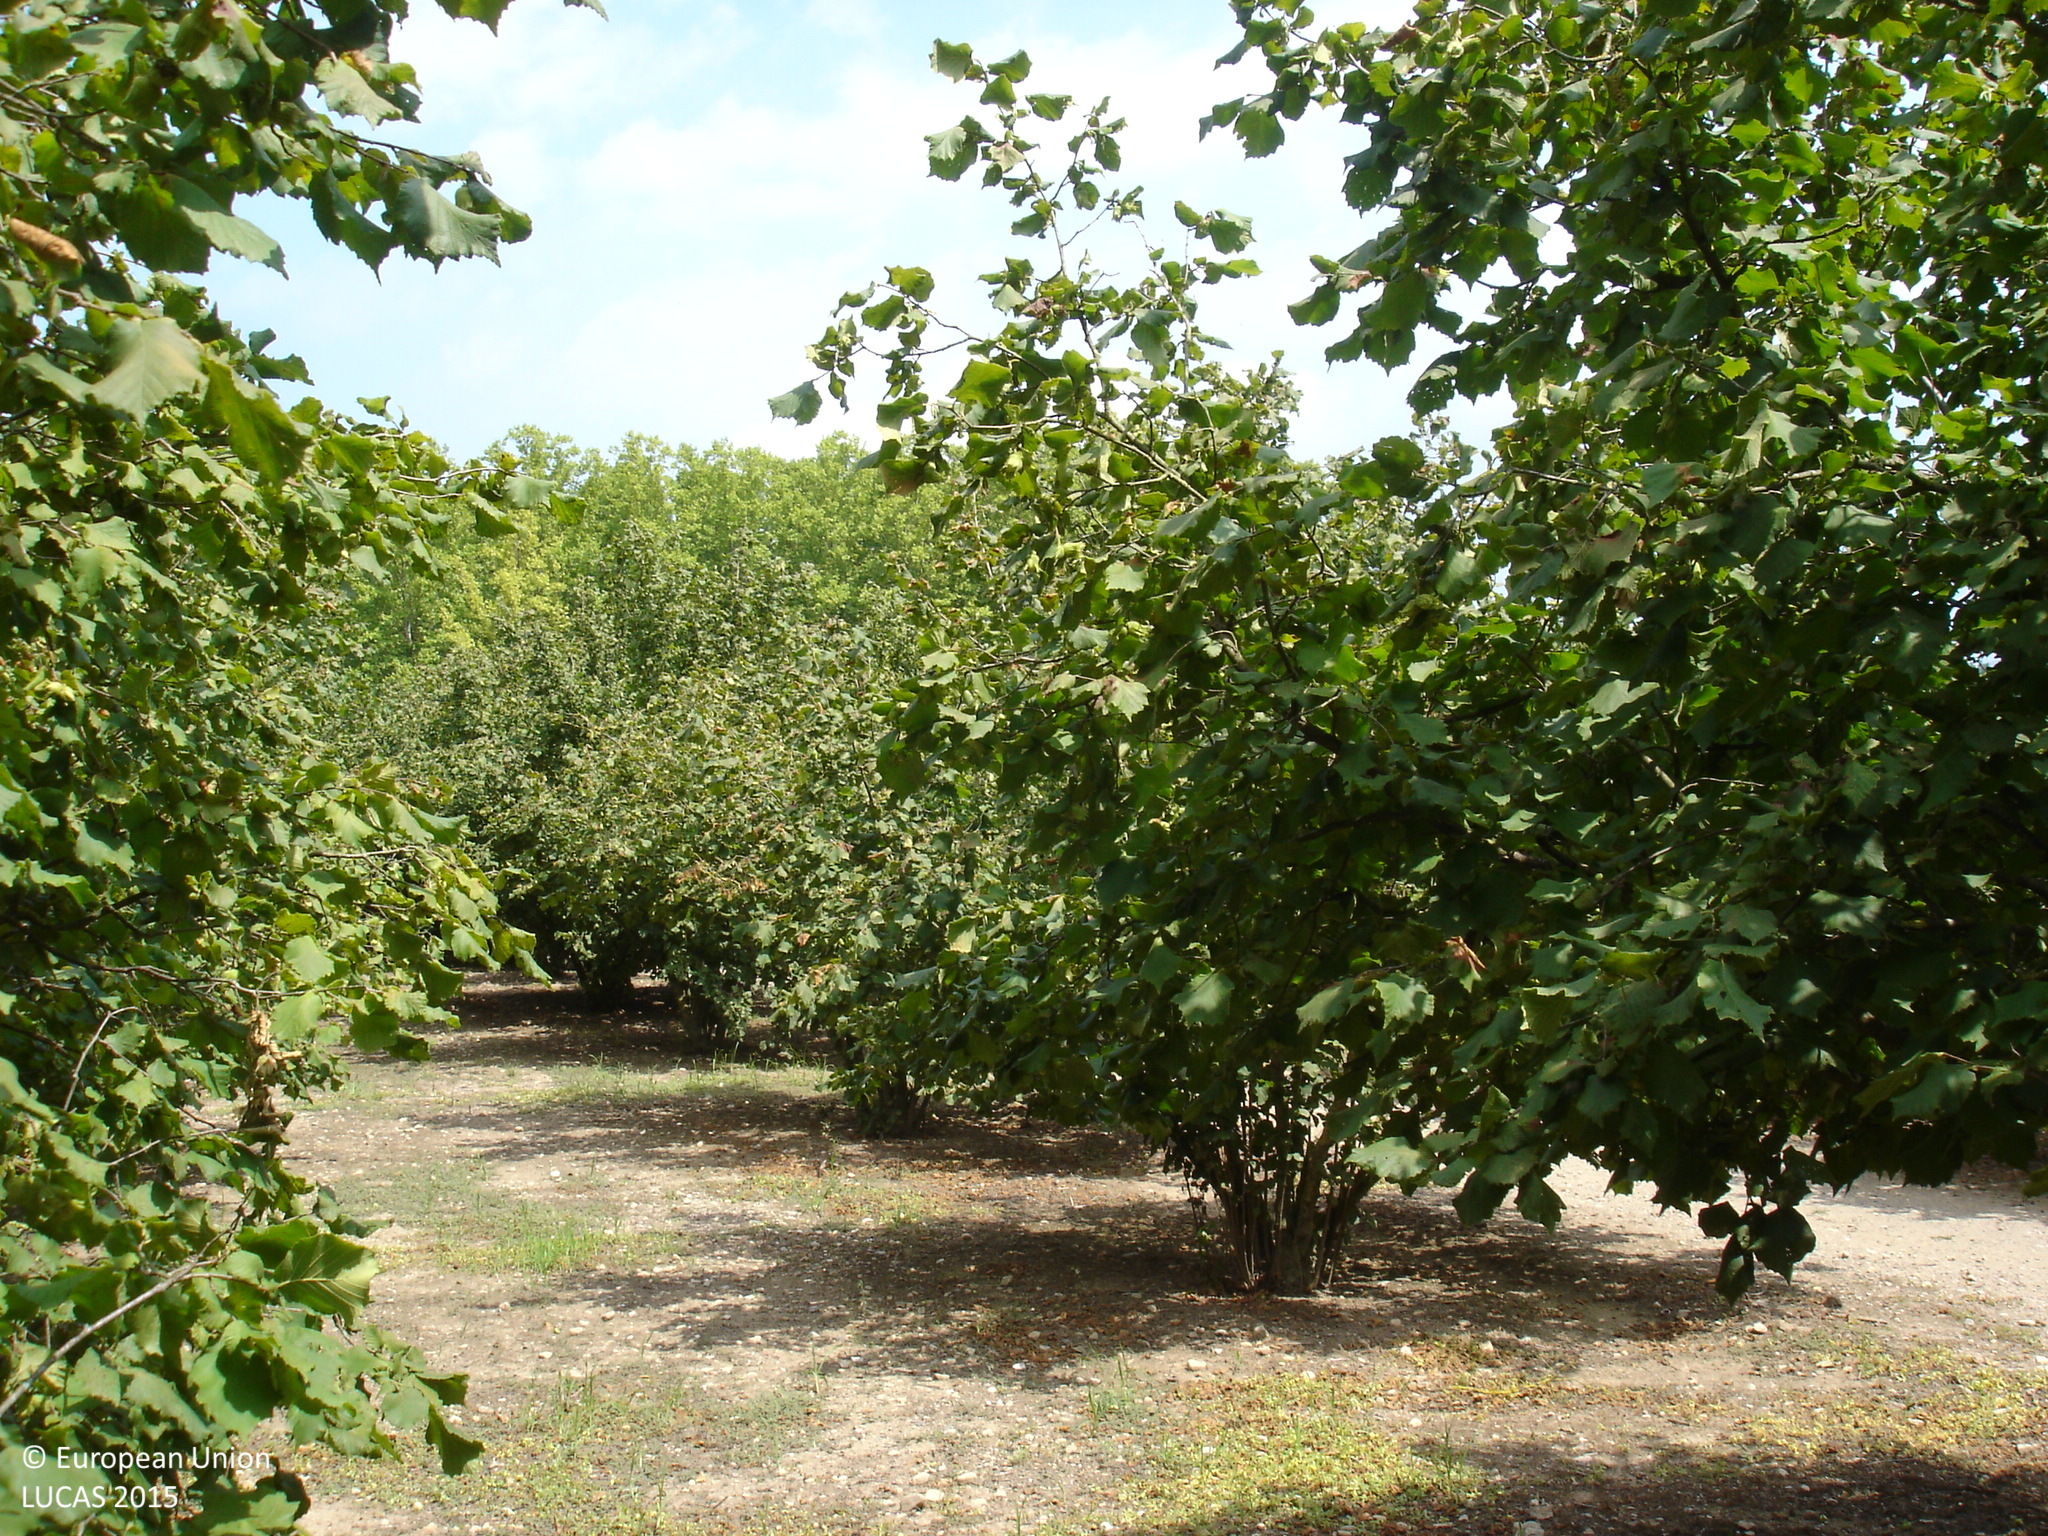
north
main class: Cropland
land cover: Nuts trees
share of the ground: 50 - 75 %
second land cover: Other bare soil
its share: > 75 %
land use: Agriculture (excluding fallow land and kitchen gardens)
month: July
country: ES
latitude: 41.9854
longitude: 2.6163
